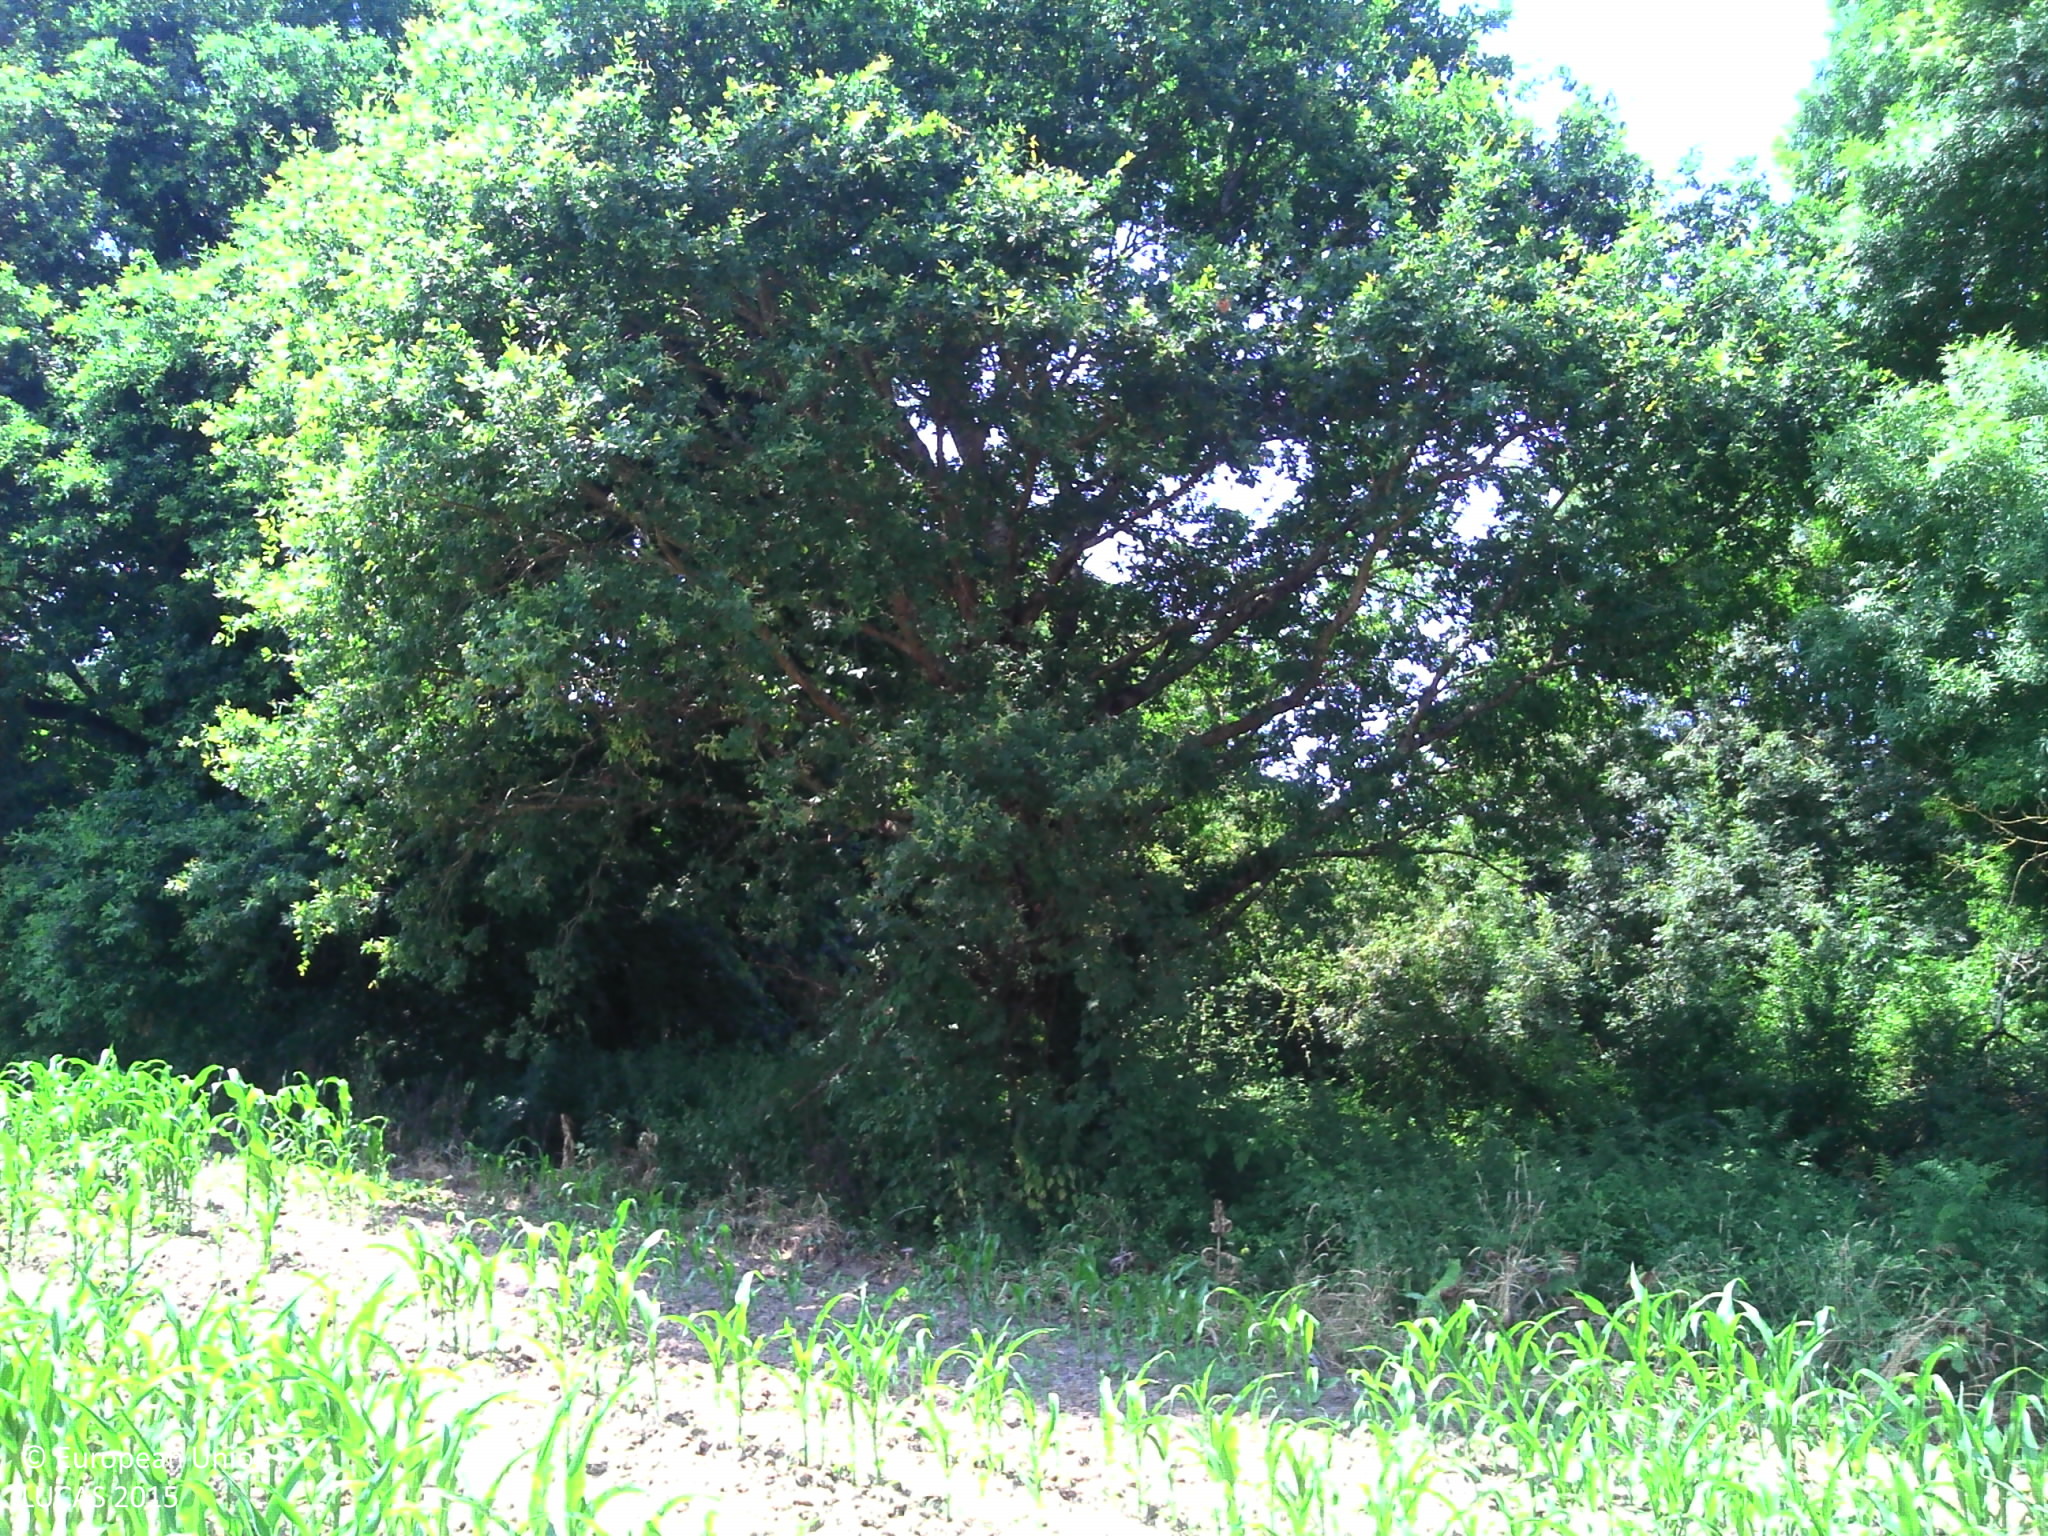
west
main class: Cropland
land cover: Maize
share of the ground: 50 - 75 %
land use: Agriculture (excluding fallow land and kitchen gardens)
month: June
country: FR
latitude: 45.7670
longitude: -0.9704
